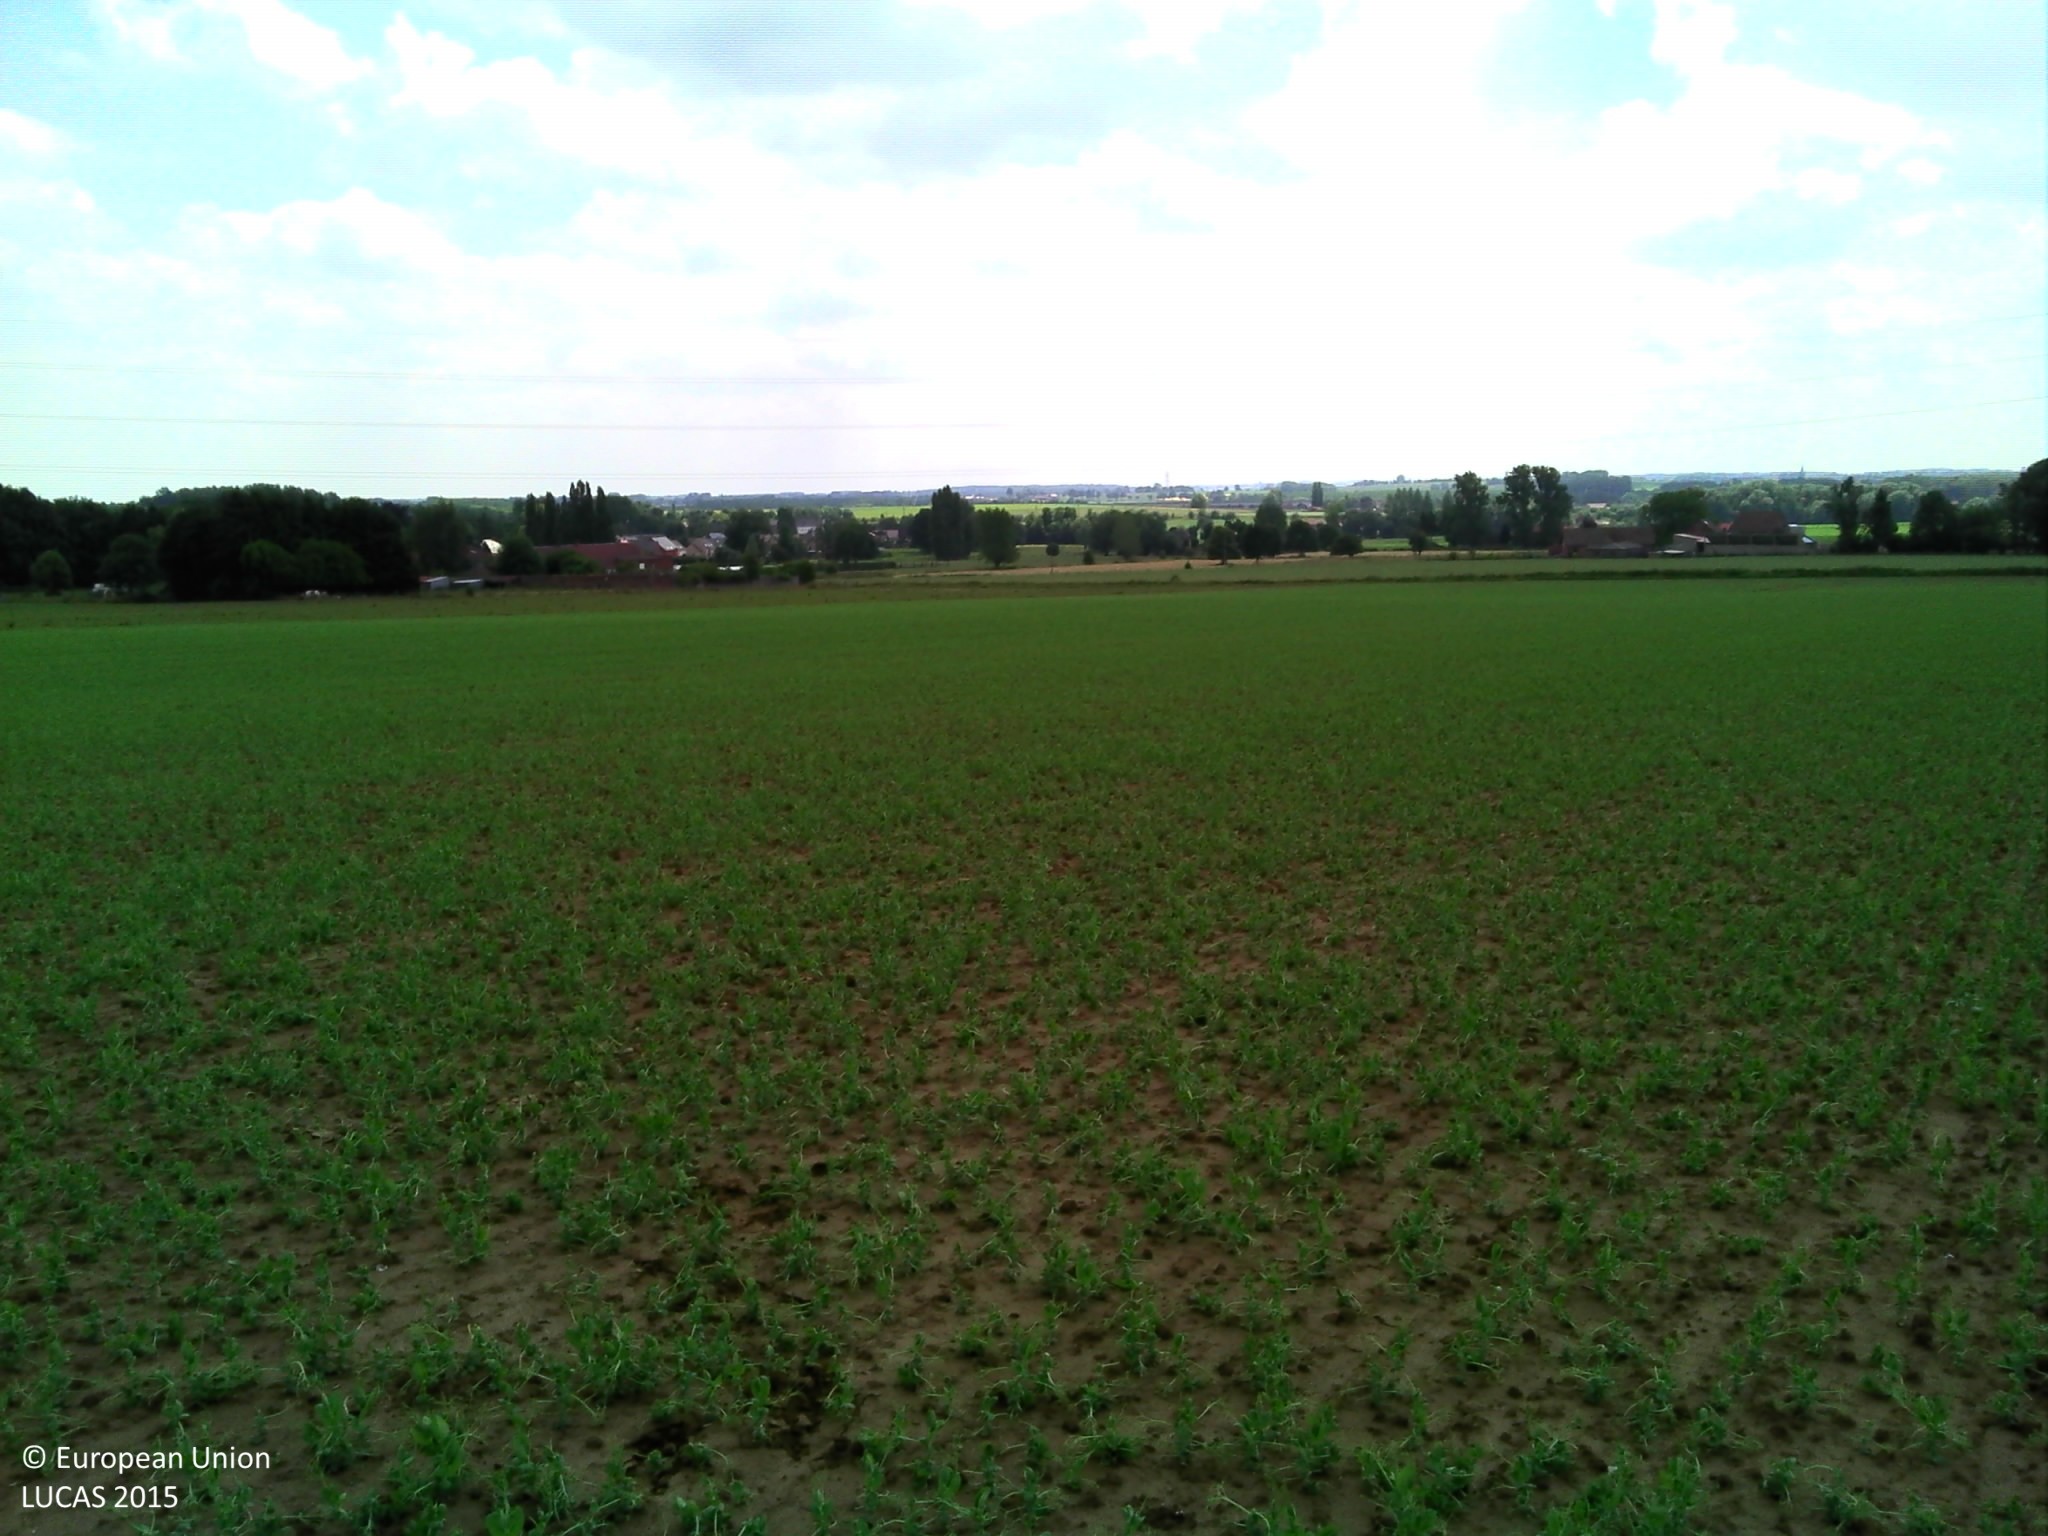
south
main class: Cropland
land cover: Dry pulses
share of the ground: 25 - 50 %
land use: Agriculture (excluding fallow land and kitchen gardens)
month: June
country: BE
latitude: 50.6295
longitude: 3.8156
